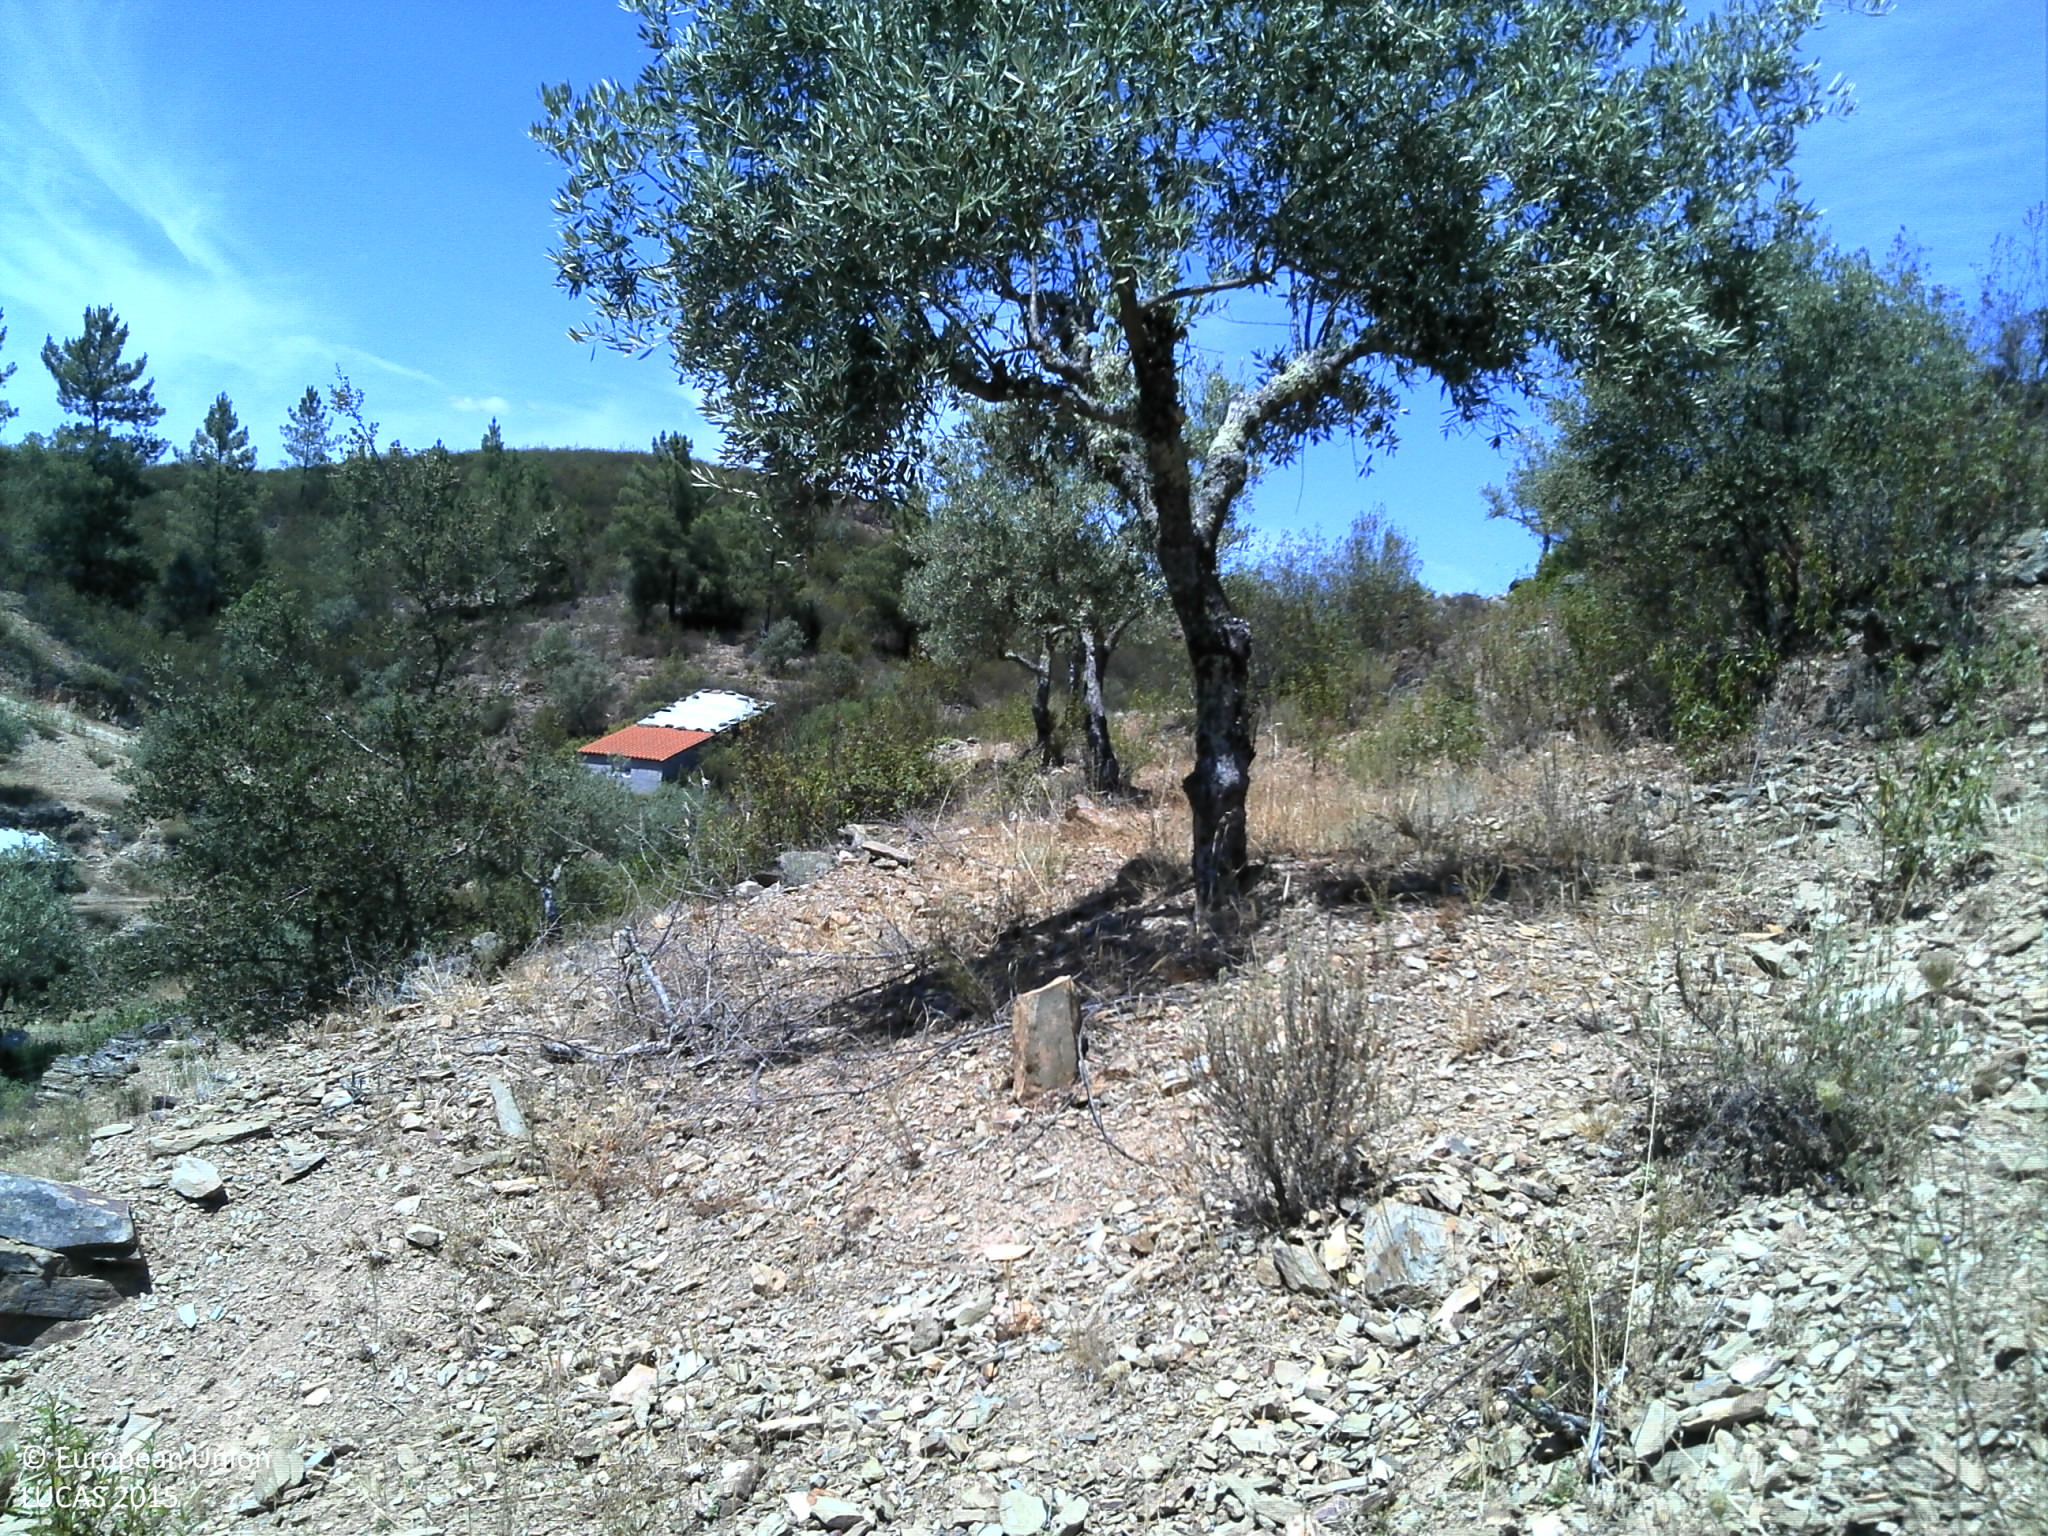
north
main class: Cropland
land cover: Olive groves
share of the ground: 10 - 25 %
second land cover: Shrubland without tree cover
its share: 10 - 25 %
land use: Agriculture (excluding fallow land and kitchen gardens)
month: July
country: PT
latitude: 39.6486
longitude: -7.7579
